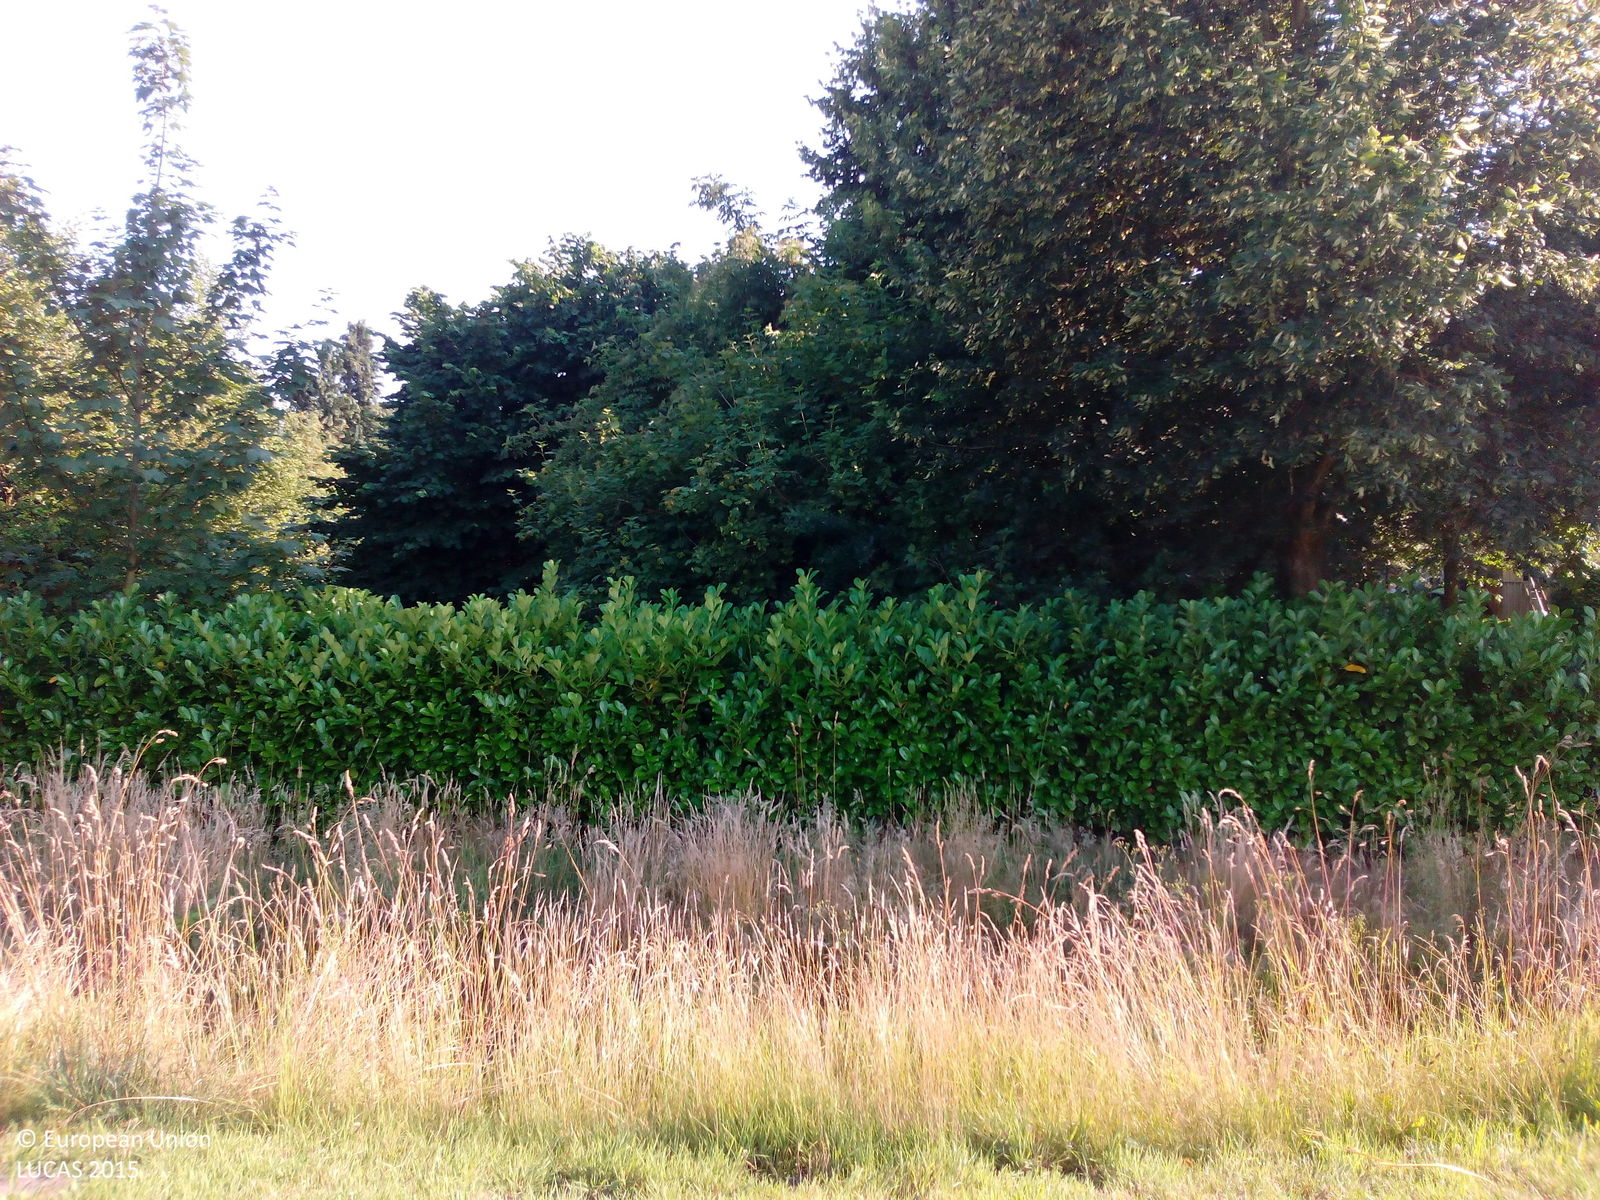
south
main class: Cropland
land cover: Barley
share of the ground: > 75 %
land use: Agriculture (excluding fallow land and kitchen gardens)
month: July
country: DE
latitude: 52.4857
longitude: 7.9536
